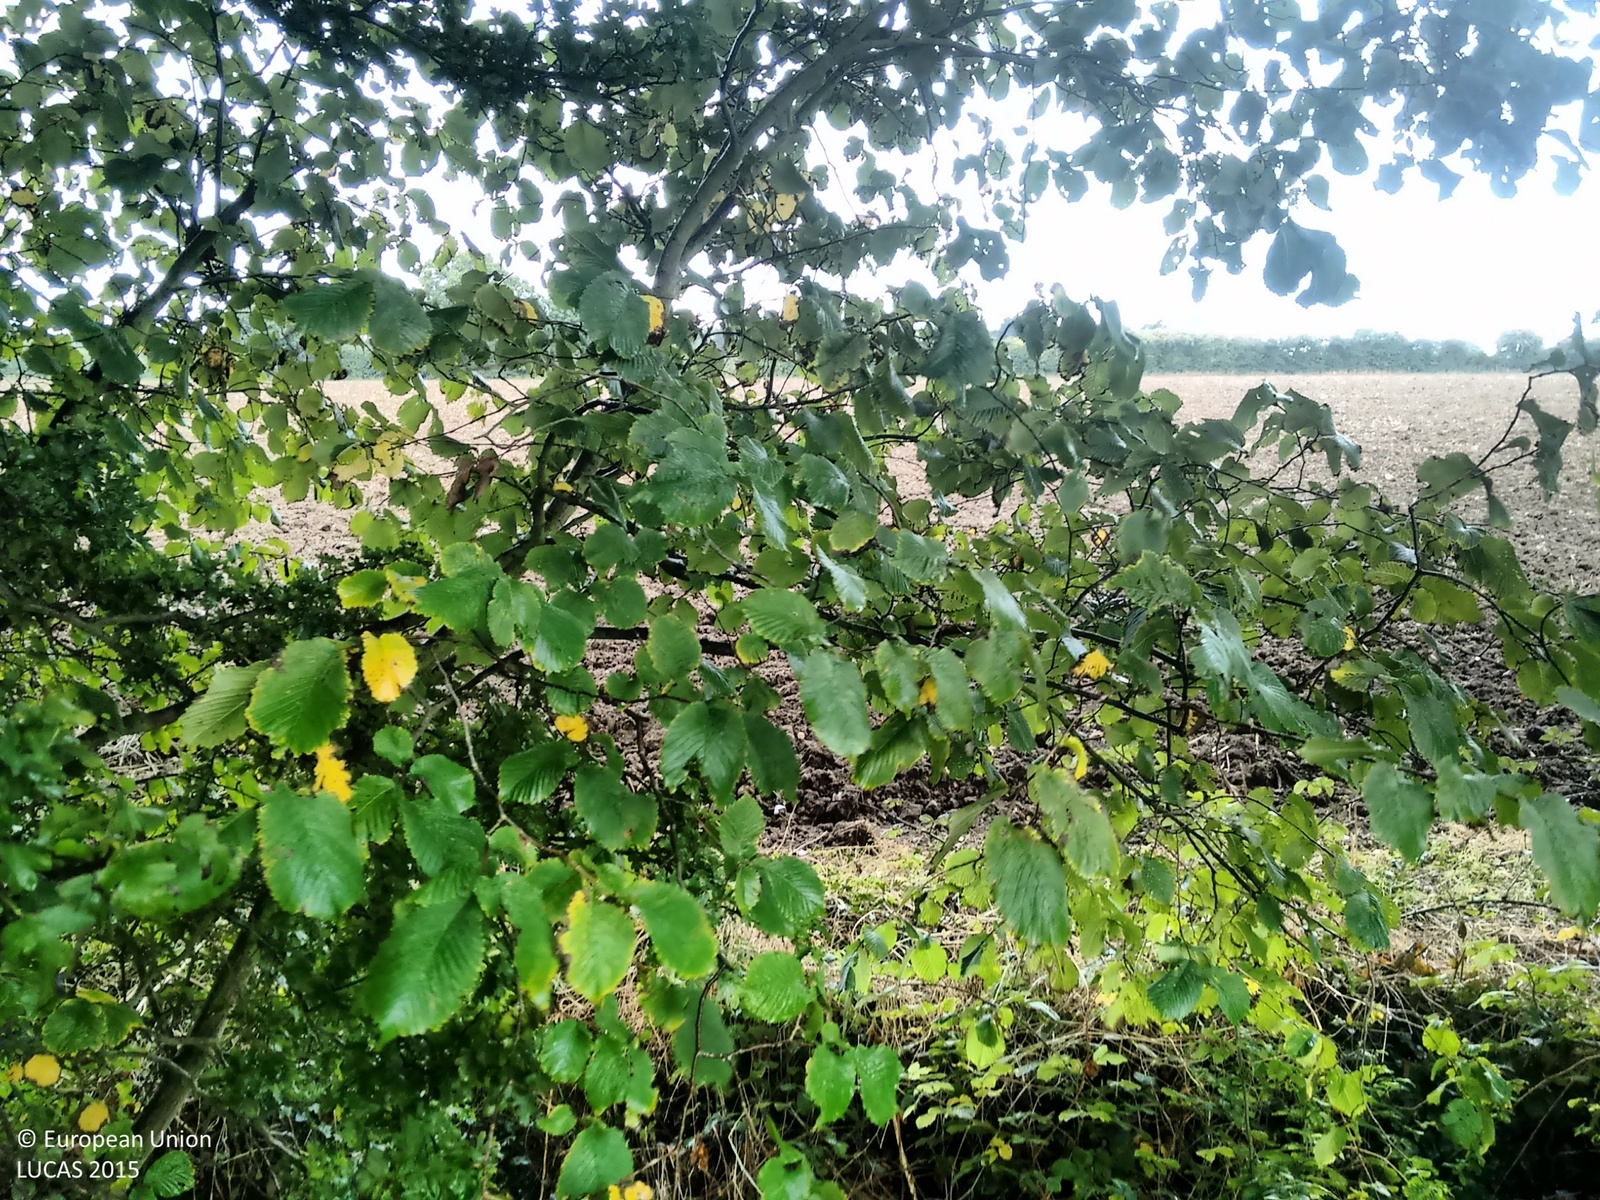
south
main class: Grassland
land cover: Spontaneously vegetated surfaces
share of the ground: > 75 %
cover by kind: herbaceous plants 100 %
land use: Agriculture (excluding fallow land and kitchen gardens)
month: September
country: GB
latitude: 52.2036
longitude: 1.5676
